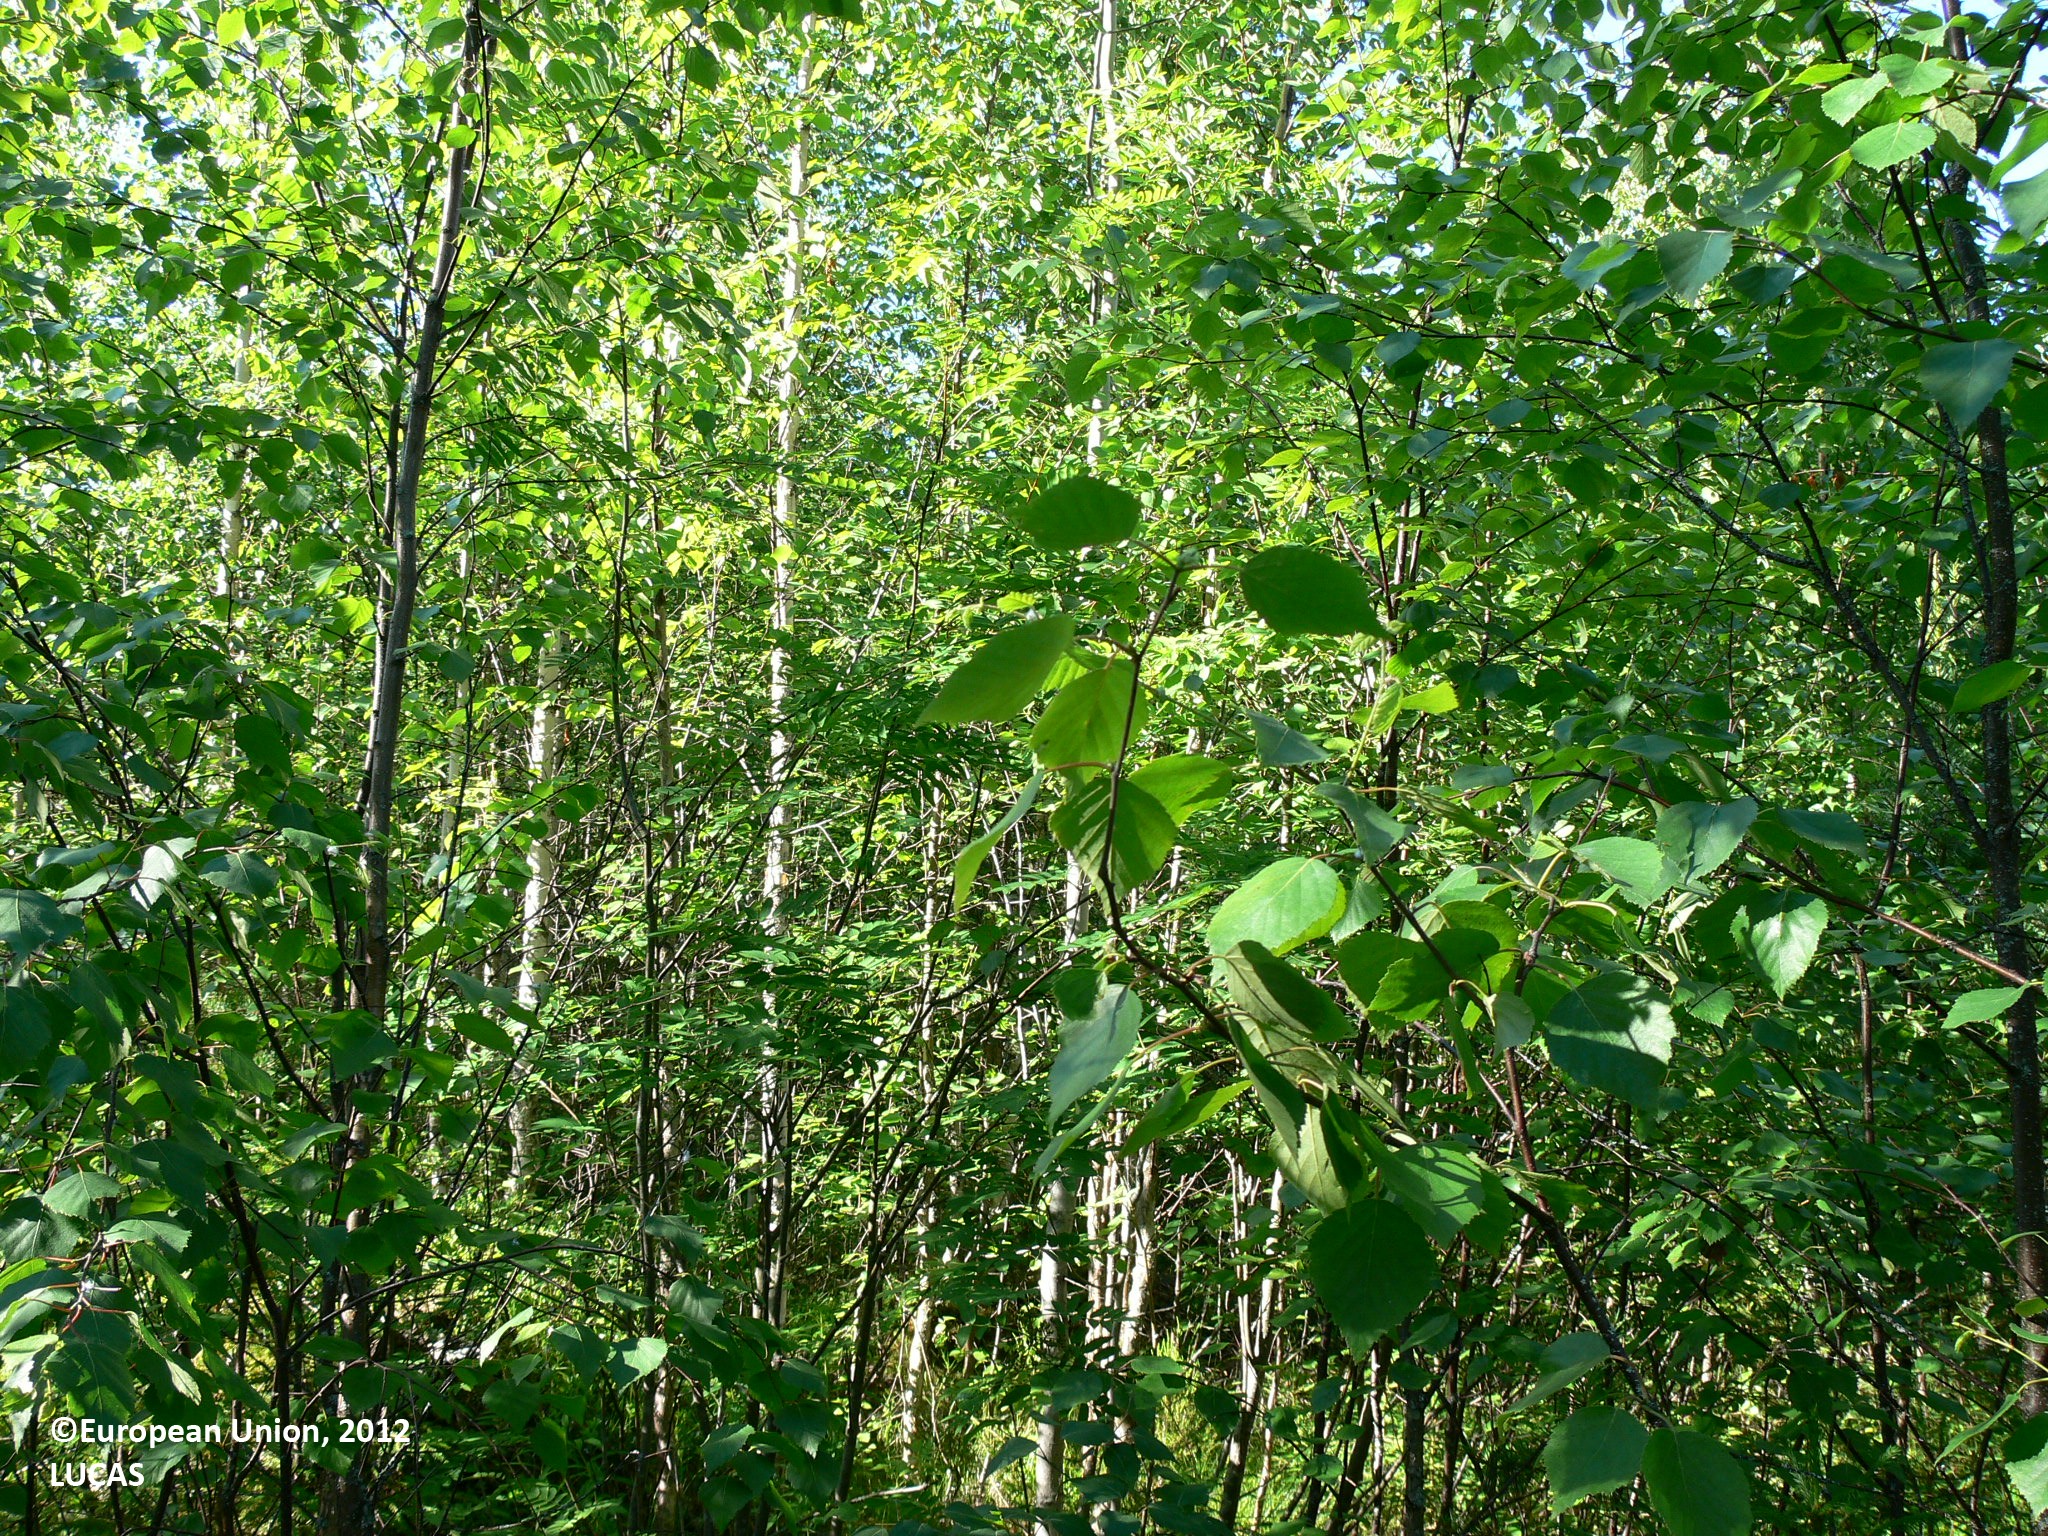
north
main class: Woodland
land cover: Pine dominated mixed woodland
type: boreal forest
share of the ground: > 75 %
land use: Forestry
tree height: > 5 m
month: July
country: FI
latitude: 62.8842
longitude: 30.7619
